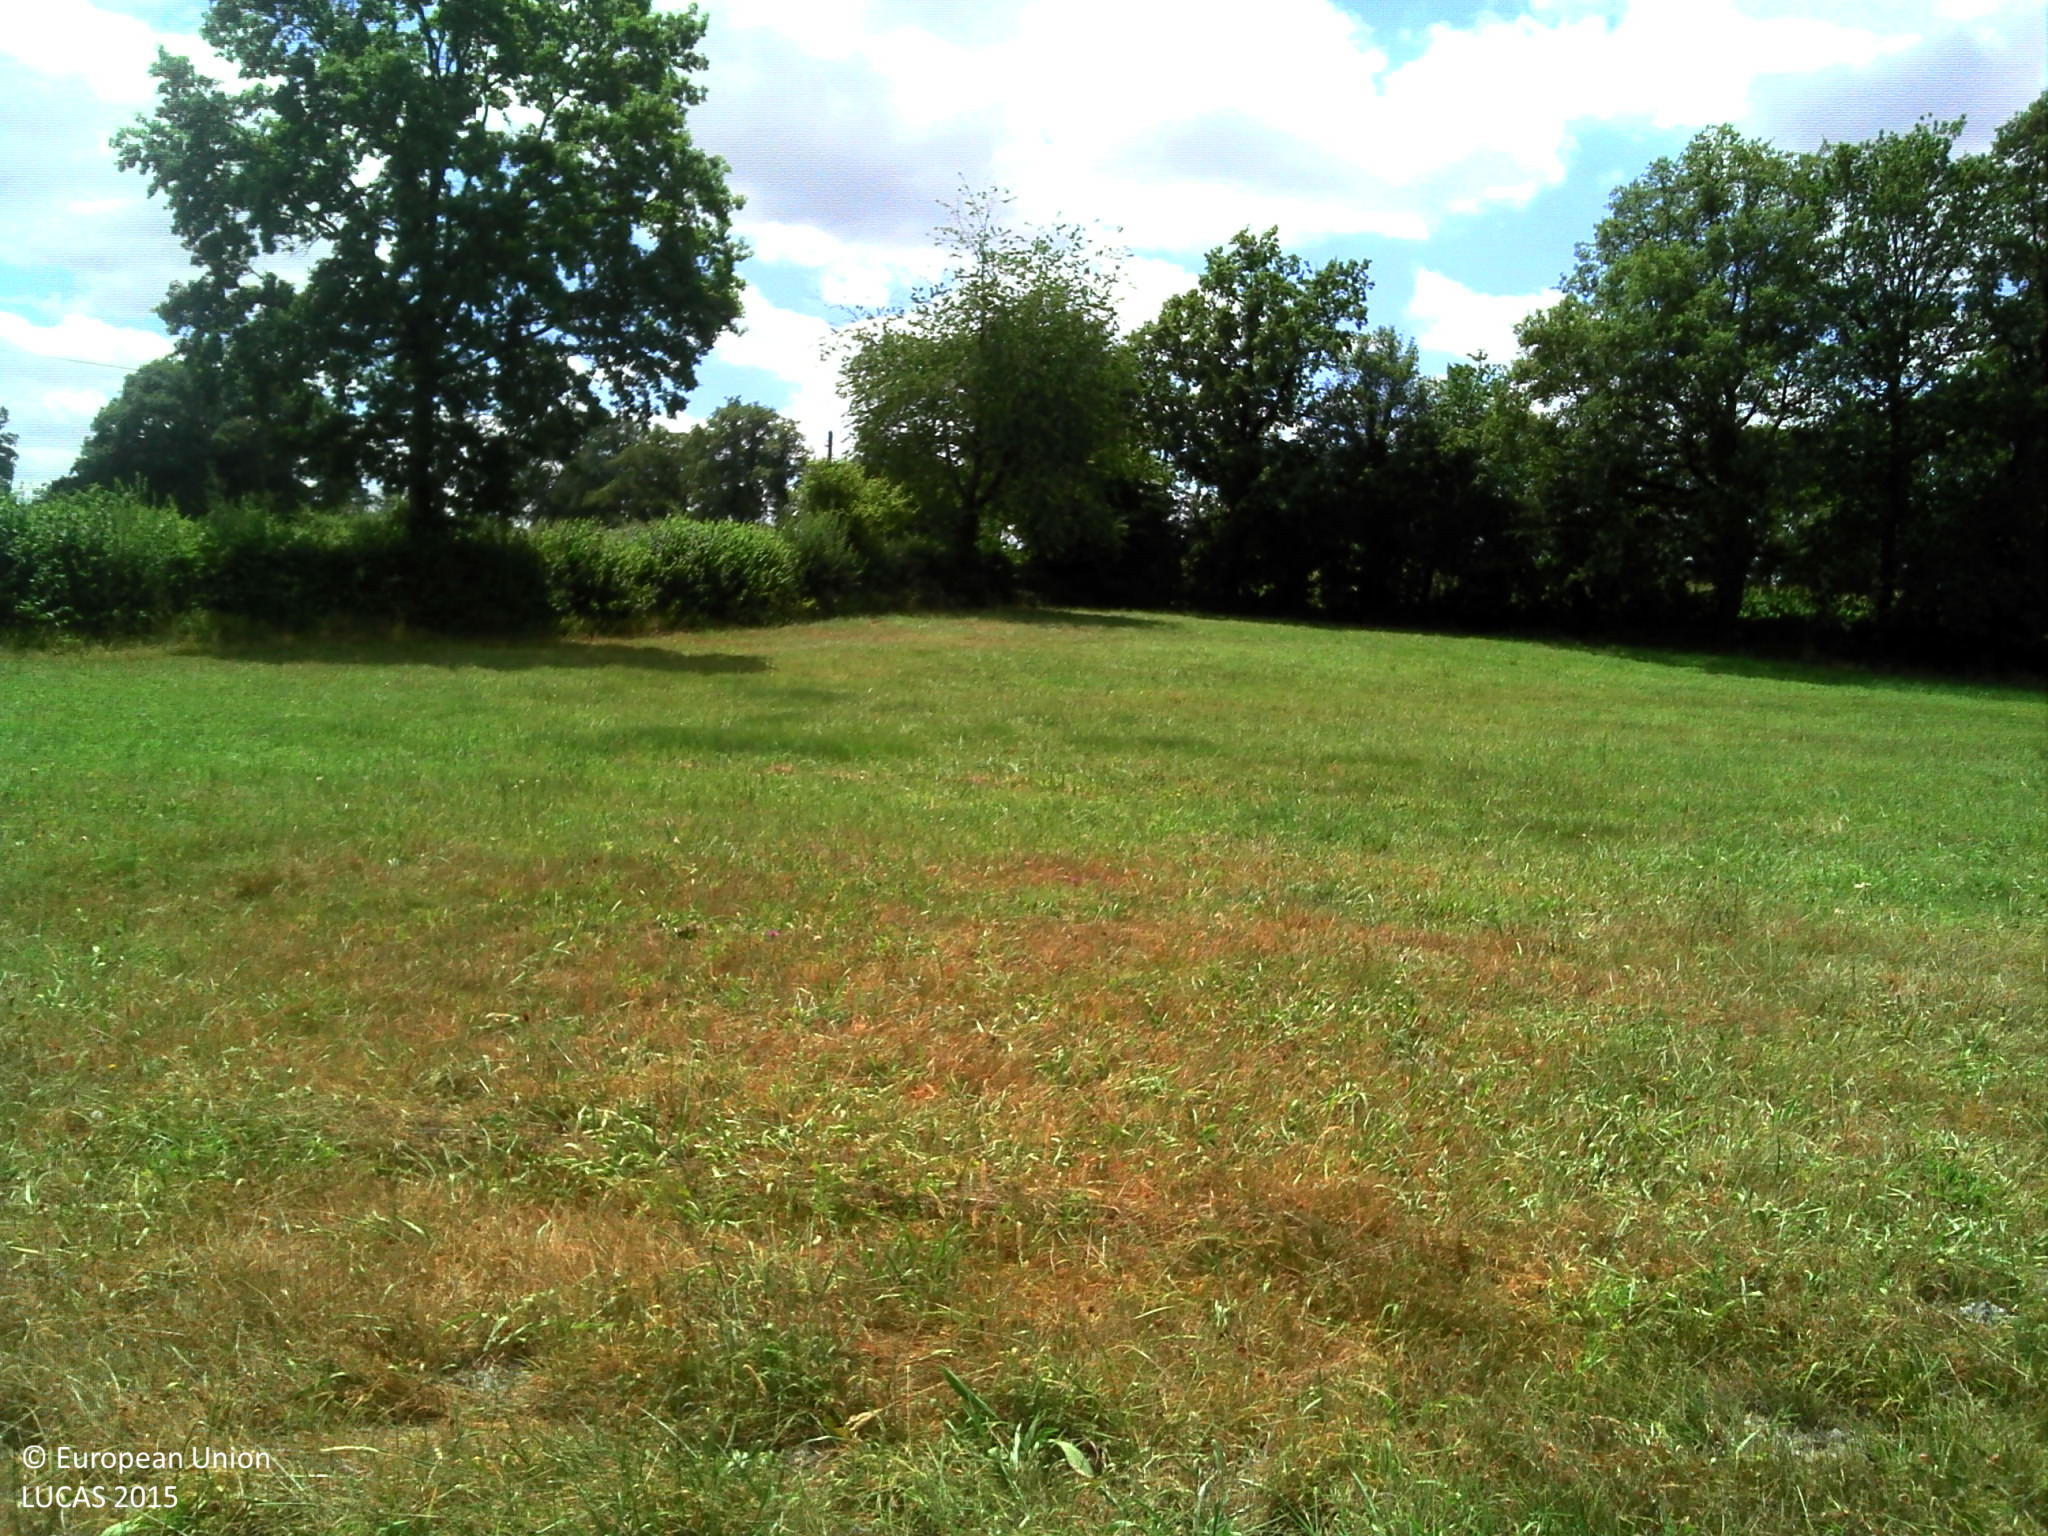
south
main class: Grassland
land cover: Grassland without tree/shrub cover
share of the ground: > 75 %
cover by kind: herbaceous plants 100 %
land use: Agriculture (excluding fallow land and kitchen gardens)
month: July
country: FR
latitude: 46.4637
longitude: 2.1938
